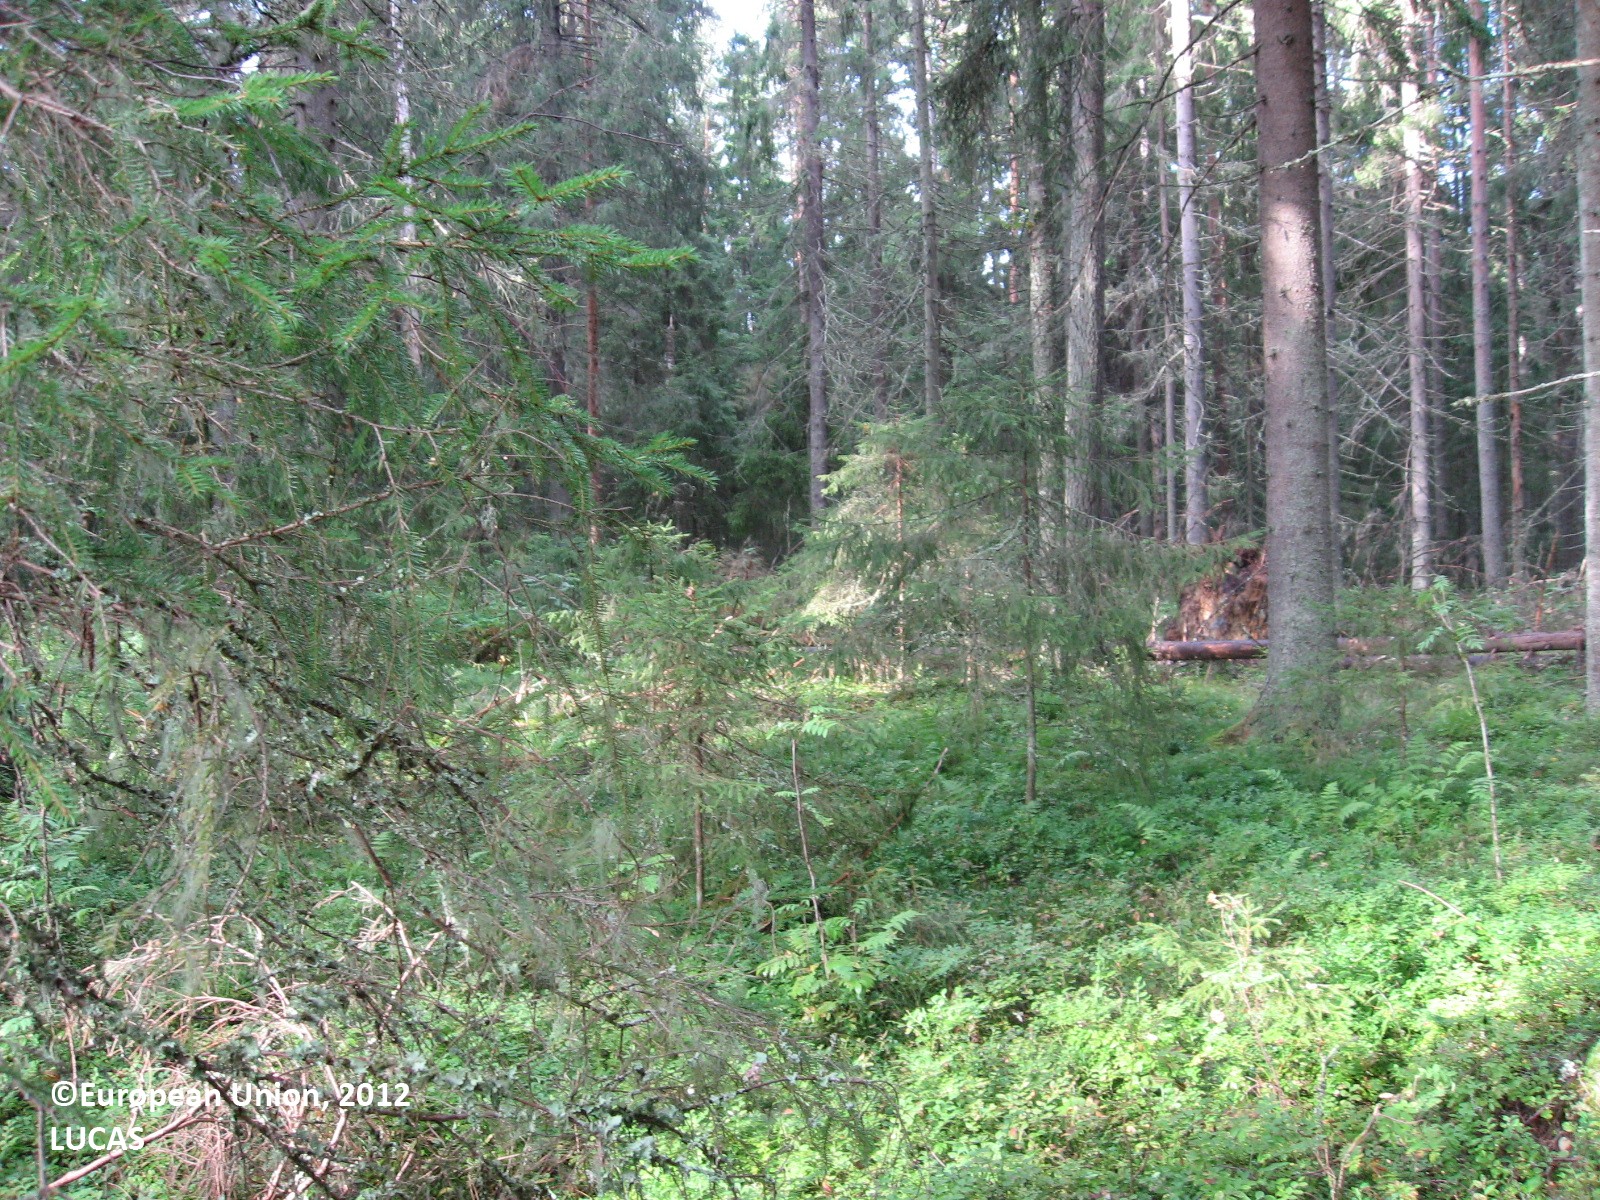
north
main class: Woodland
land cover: Spruce dominated coniferous woodland
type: boreal forest
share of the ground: > 75 %
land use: Forestry
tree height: > 5 m
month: August
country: FI
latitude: 61.5792
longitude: 24.8144
